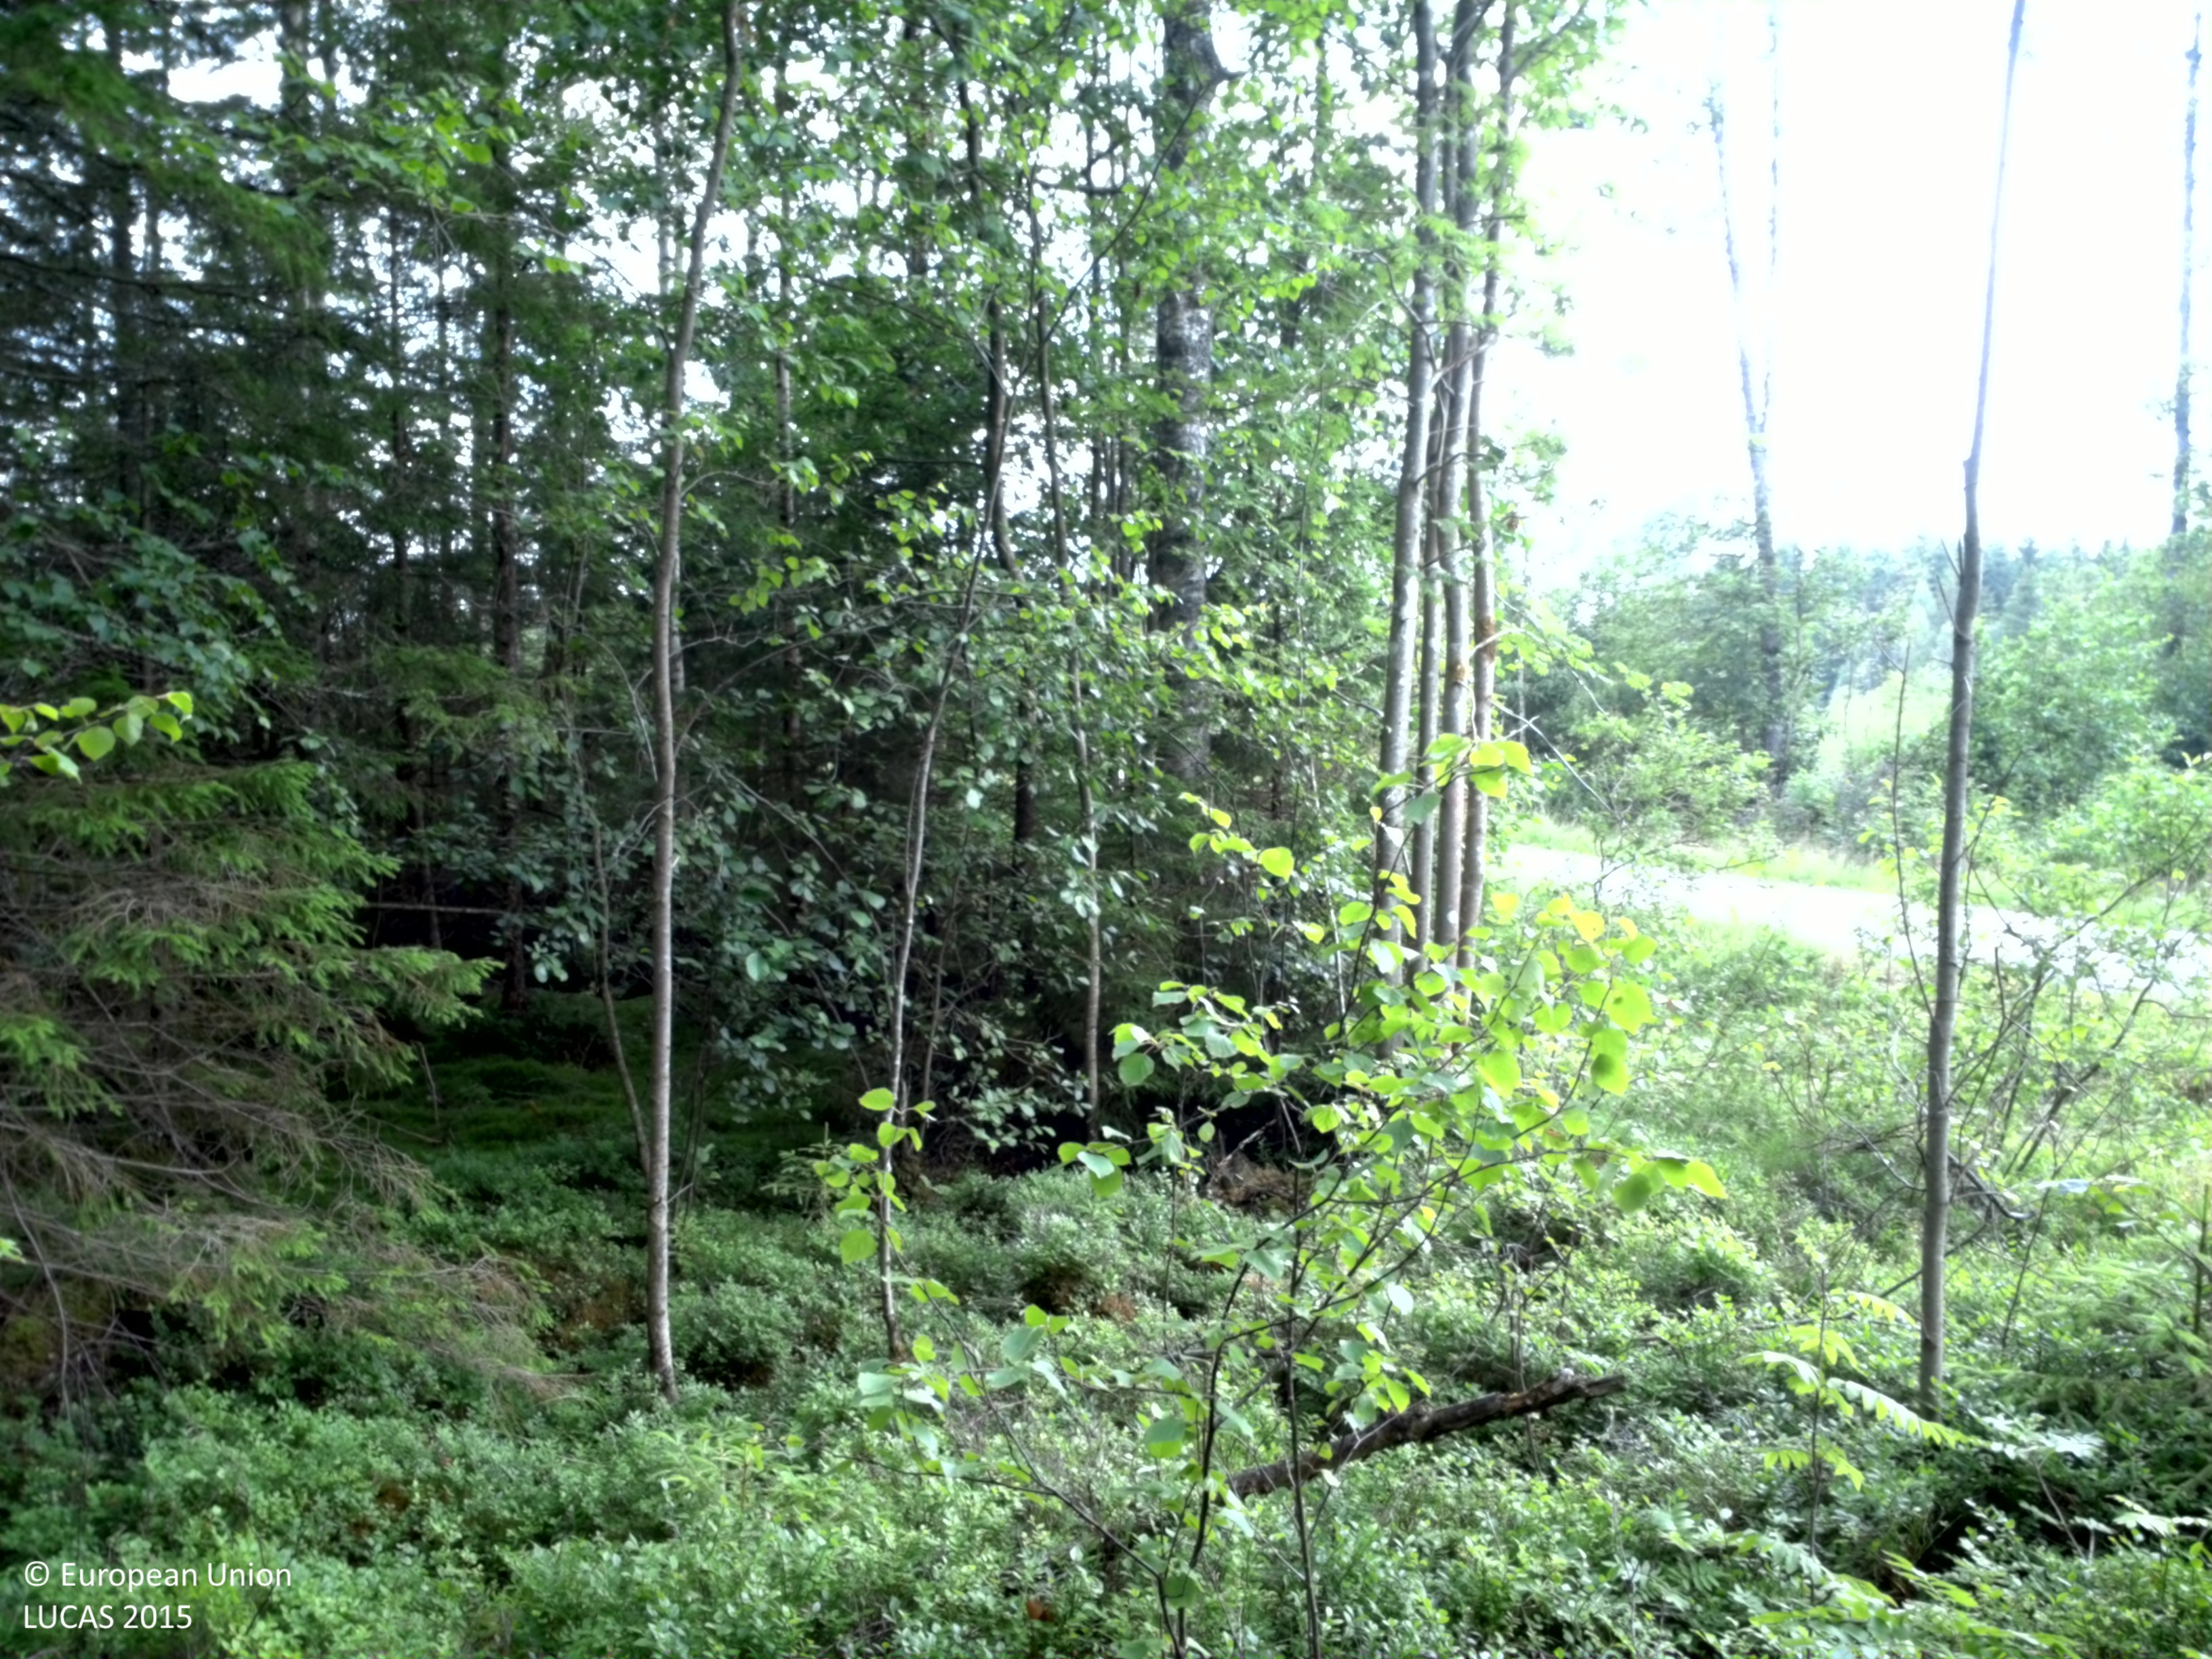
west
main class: Woodland
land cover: Other mixed woodland
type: boreal forest
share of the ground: 50 - 75 %
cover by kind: coniferous forest trees 40 %, shrubs 30 %, broadleaved forest trees 25 %, lichens and mosses 5 %
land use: Forestry
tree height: > 5 m
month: July
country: SE
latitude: 58.7411
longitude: 14.4333
